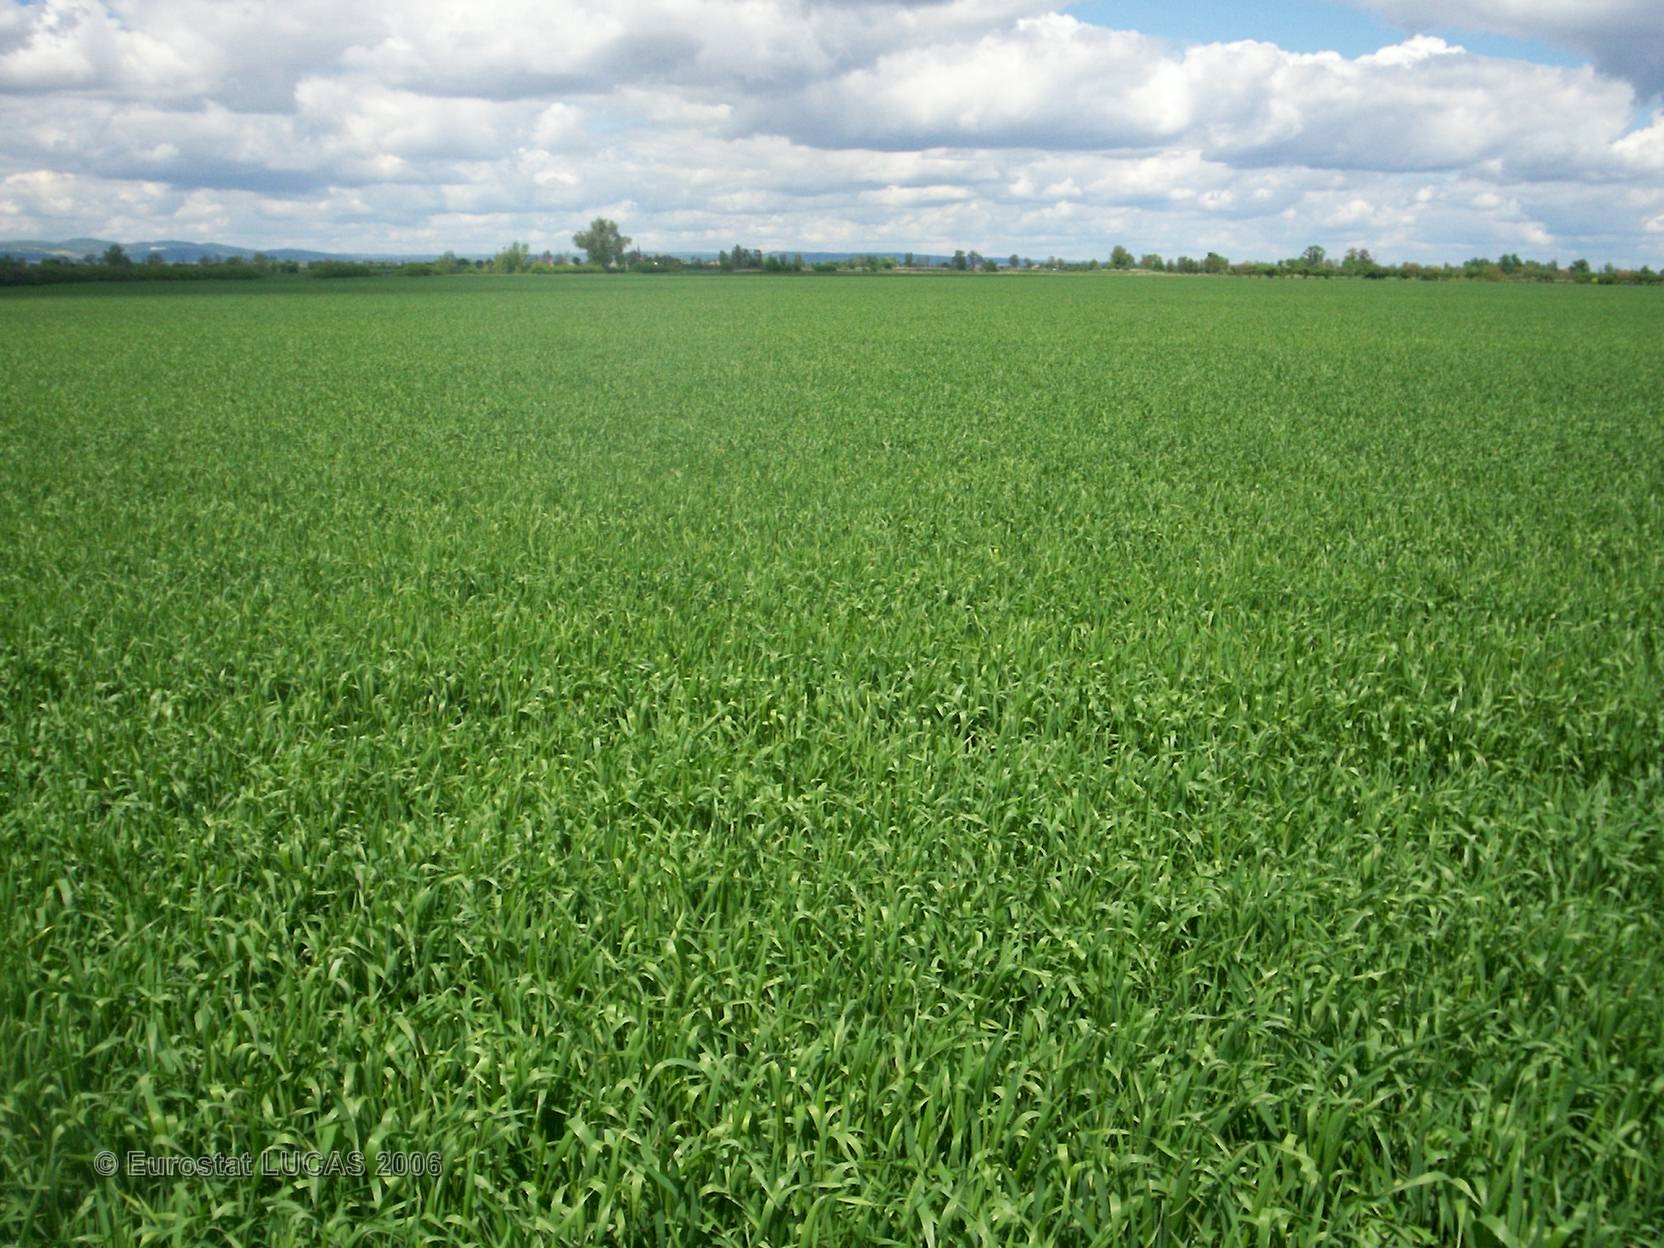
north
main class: Cropland
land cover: Common wheat
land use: Agriculture (excluding fallow land and kitchen gardens)
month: May
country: FR
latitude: 45.8268
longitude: 3.1904
